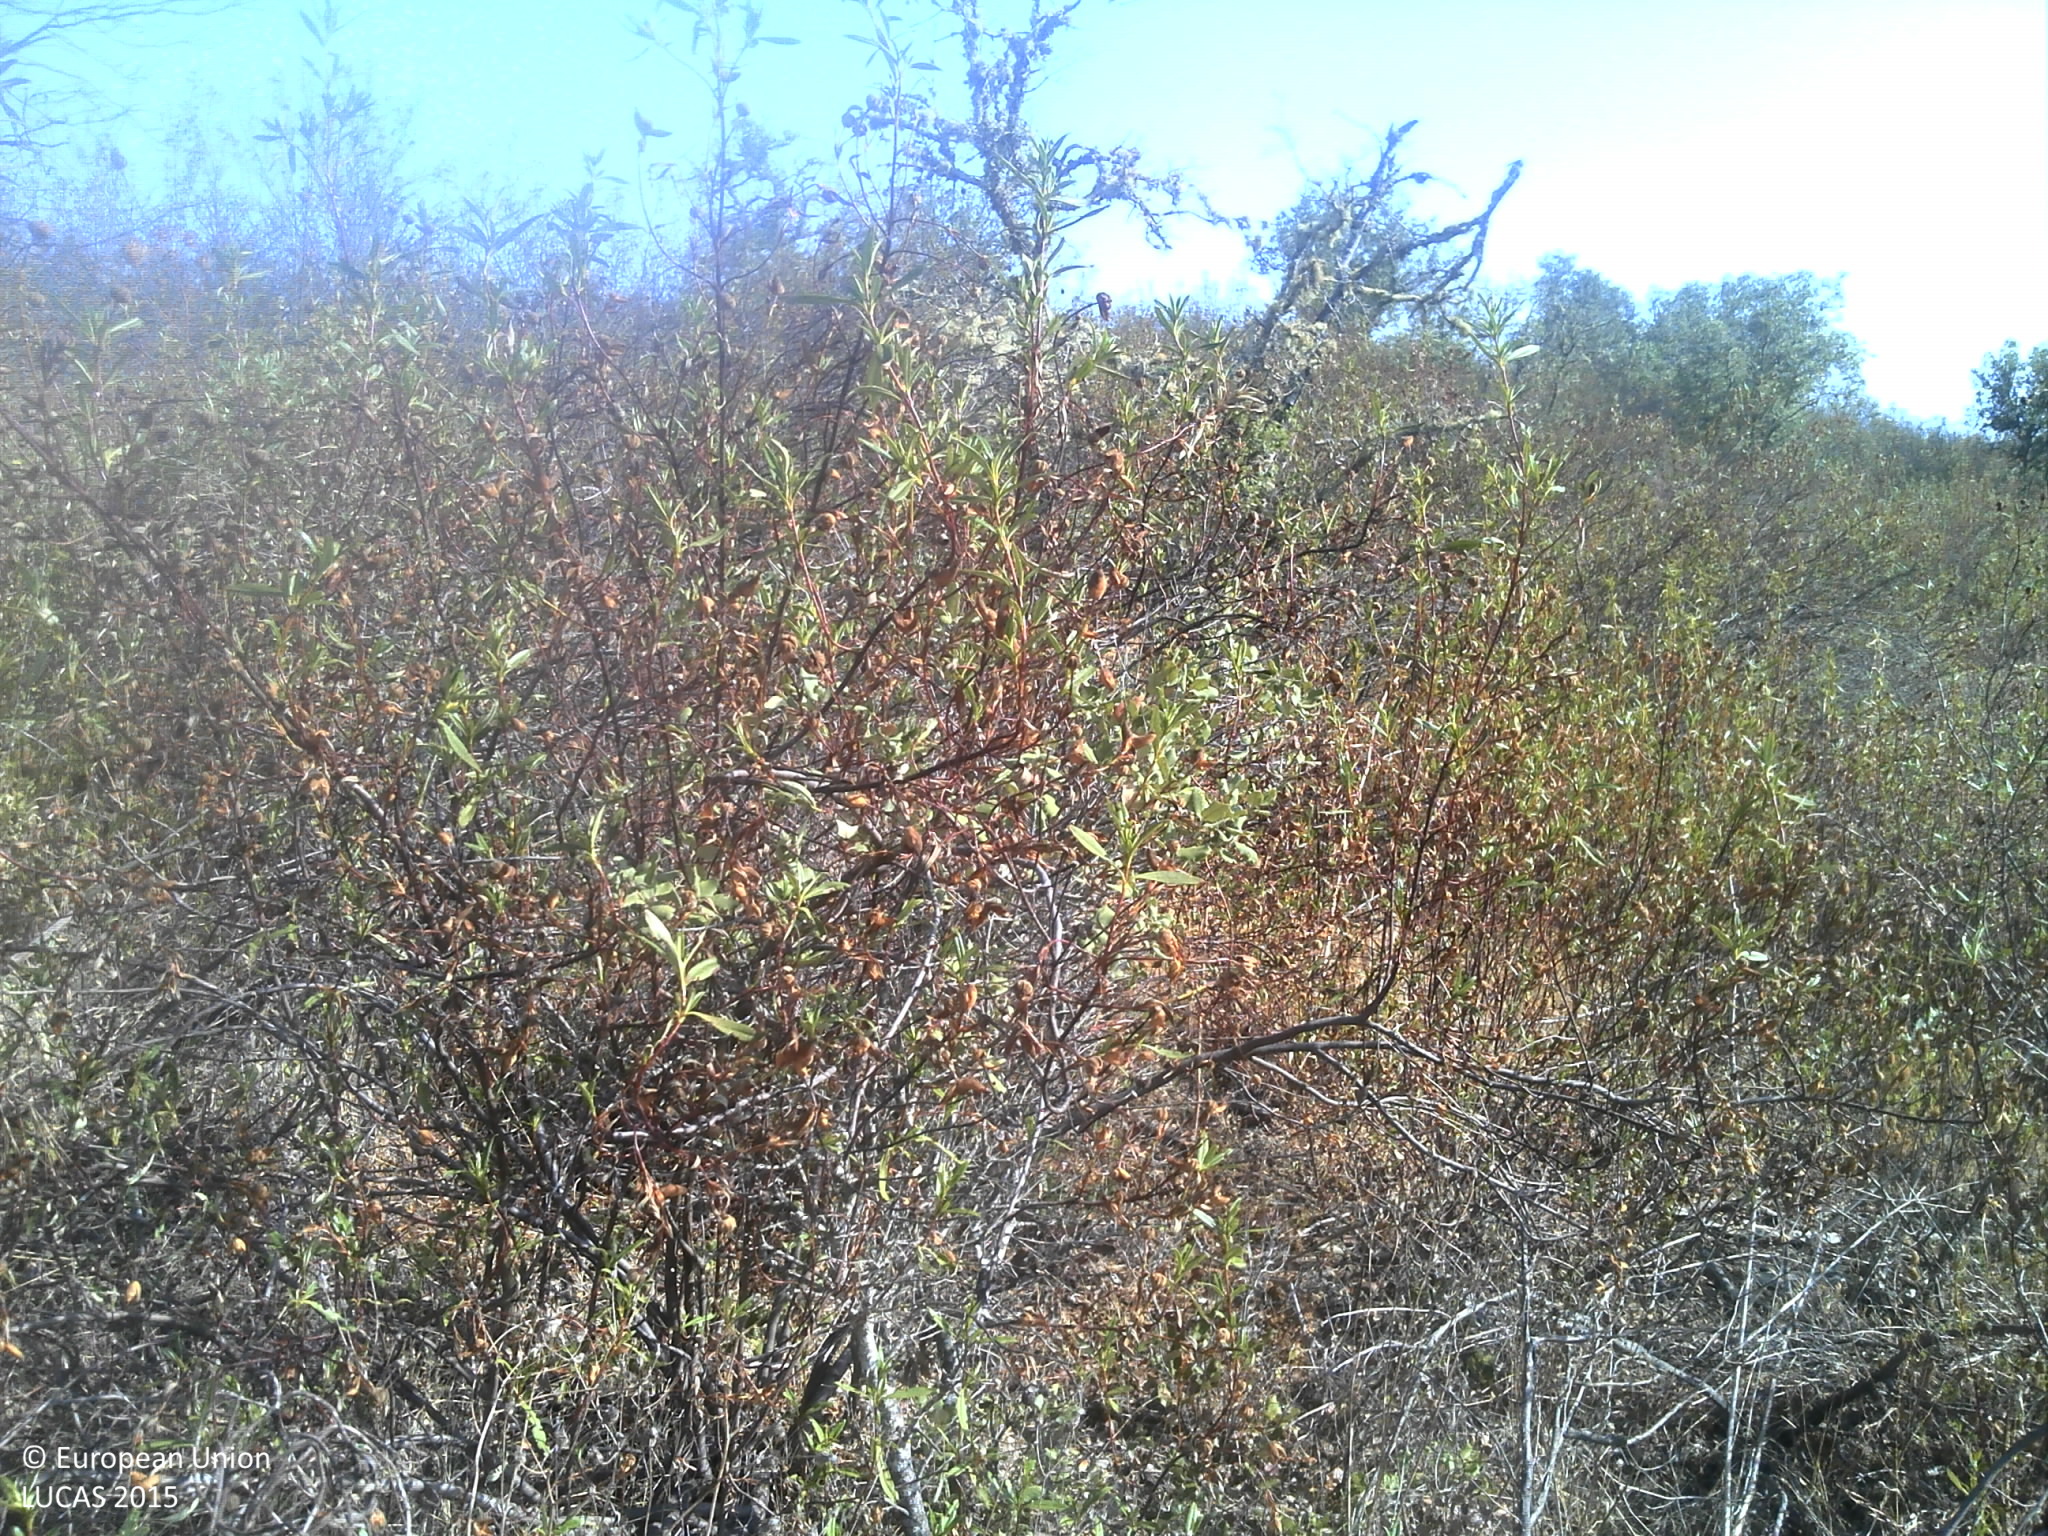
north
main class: Shrubland
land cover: Shrubland with sparse tree cover
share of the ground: 50 - 75 %
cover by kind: shrubs 65 %, herbaceous plants 20 %, unconsolidated bare surface 10 %, broadleaved forest trees 5 %
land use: Forestry
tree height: < 5 m
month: August
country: PT
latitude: 37.5598
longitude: -8.2422
